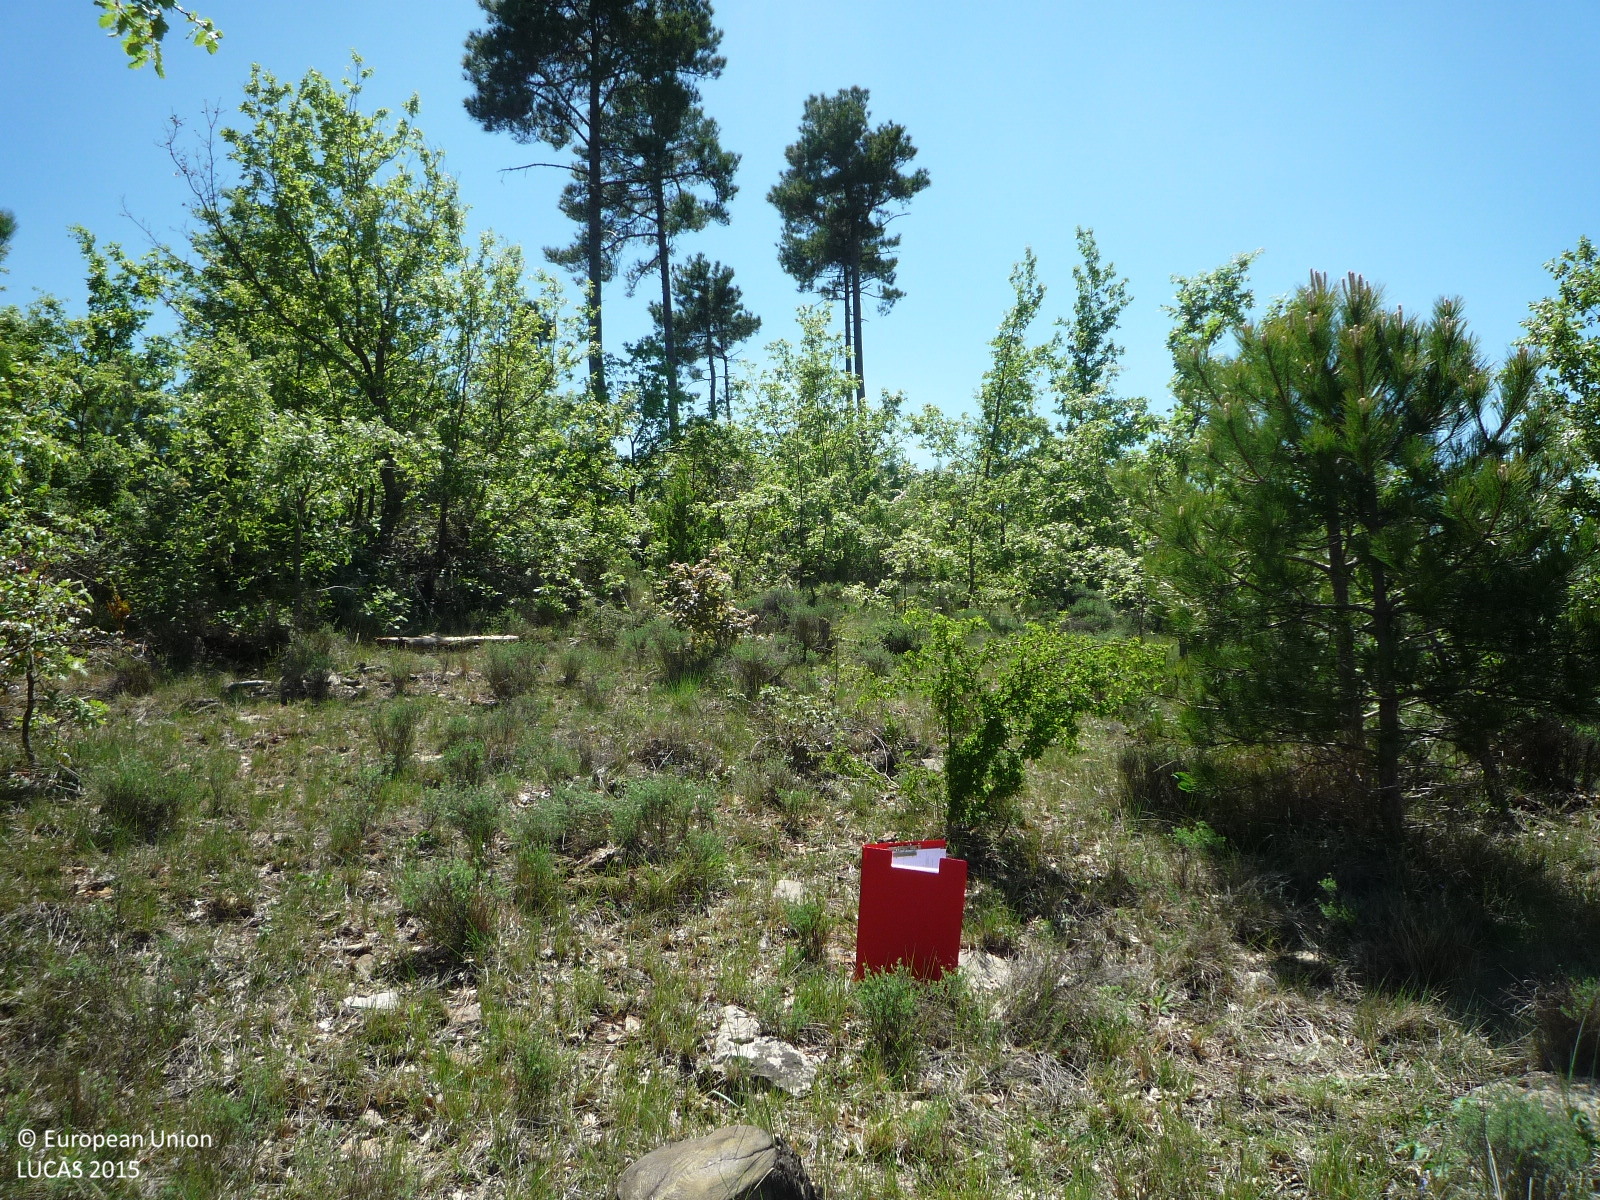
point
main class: Woodland
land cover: Other mixed woodland
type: broadleaved evergreen forest
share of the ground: > 75 %
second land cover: Spontaneously vegetated surfaces
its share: 25 - 50 %
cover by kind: herbaceous plants 40 %, broadleaved forest trees 35 %, coniferous forest trees 25 %
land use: Forestry
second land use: Agriculture (excluding fallow land and kitchen gardens)
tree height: < 5 m
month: May
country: ES
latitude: 41.7965
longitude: 1.6020
